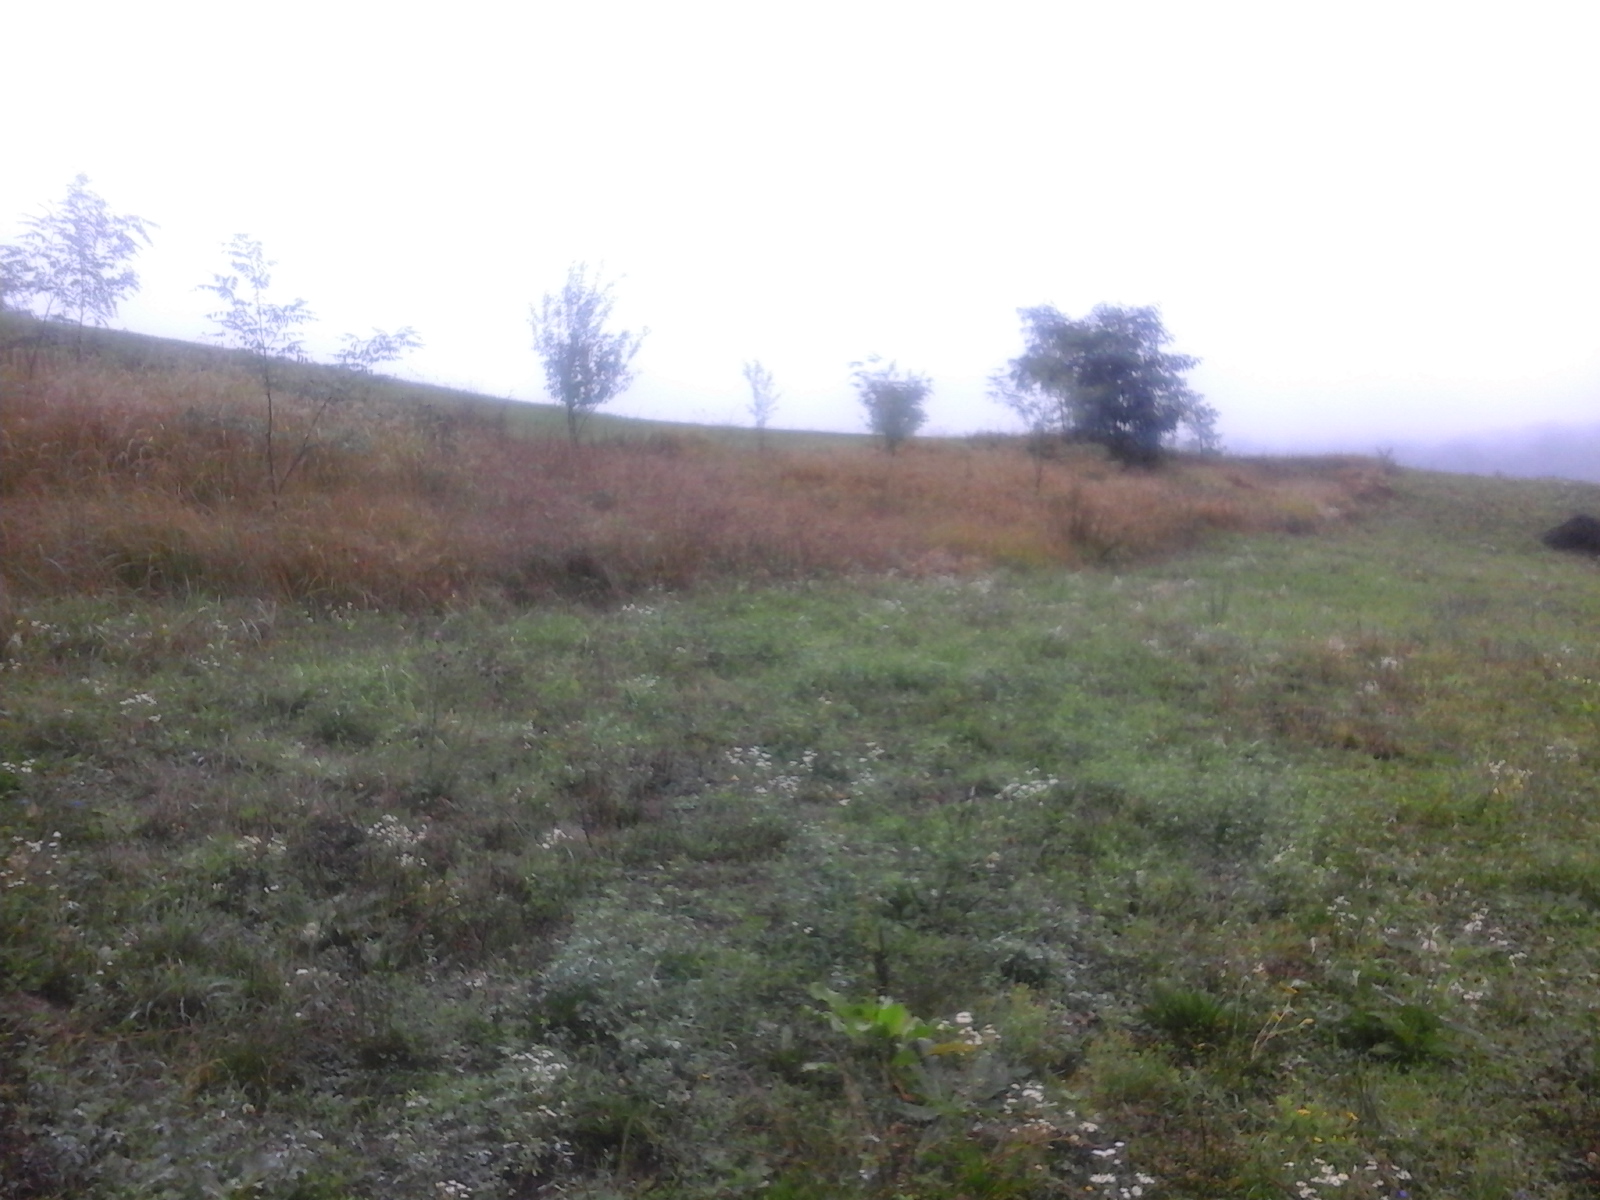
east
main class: Cropland
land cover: Other leguminous and mixtures for fodder
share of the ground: > 75 %
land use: Agriculture (excluding fallow land and kitchen gardens)
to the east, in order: Other leguminous and mixtures for fodder; Grassland with sparse tree/shrub cover; Grassland without tree/shrub cover; Spontaneously vegetated surfaces; Shrubland without tree cover; Grassland without tree/shrub cover; Electric lines; Grassland without tree/shrub cover; Abandoned hedges; Grassland without tree/shrub cover; Spontaneously vegetated surfaces
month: September
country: RO
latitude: 44.9695
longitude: 23.7162
